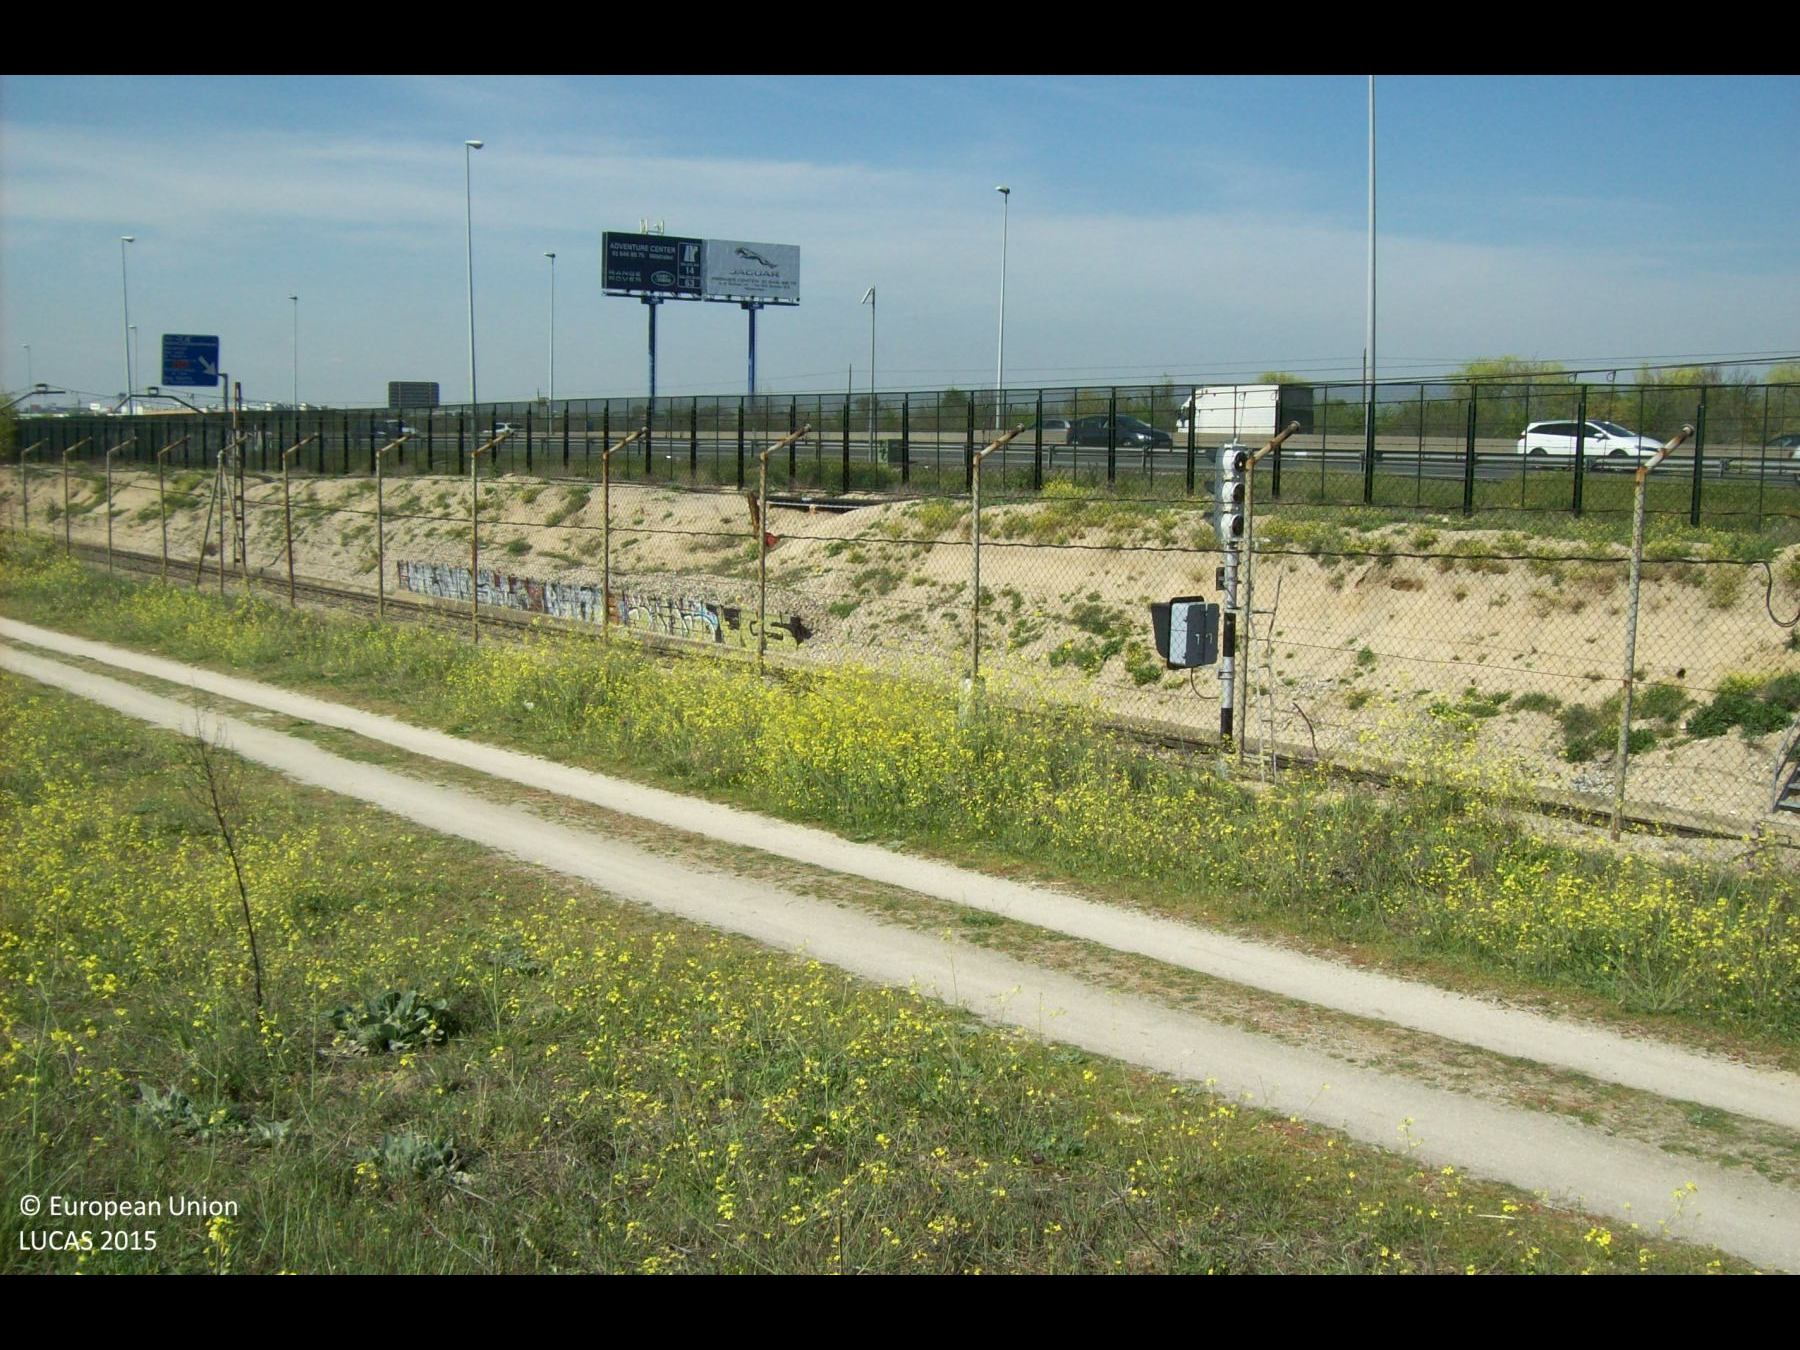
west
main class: Grassland
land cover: Grassland without tree/shrub cover
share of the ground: 50 - 75 %
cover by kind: herbaceous plants 70 %
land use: Community services
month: April
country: ES
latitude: 40.3672
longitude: -3.8051
